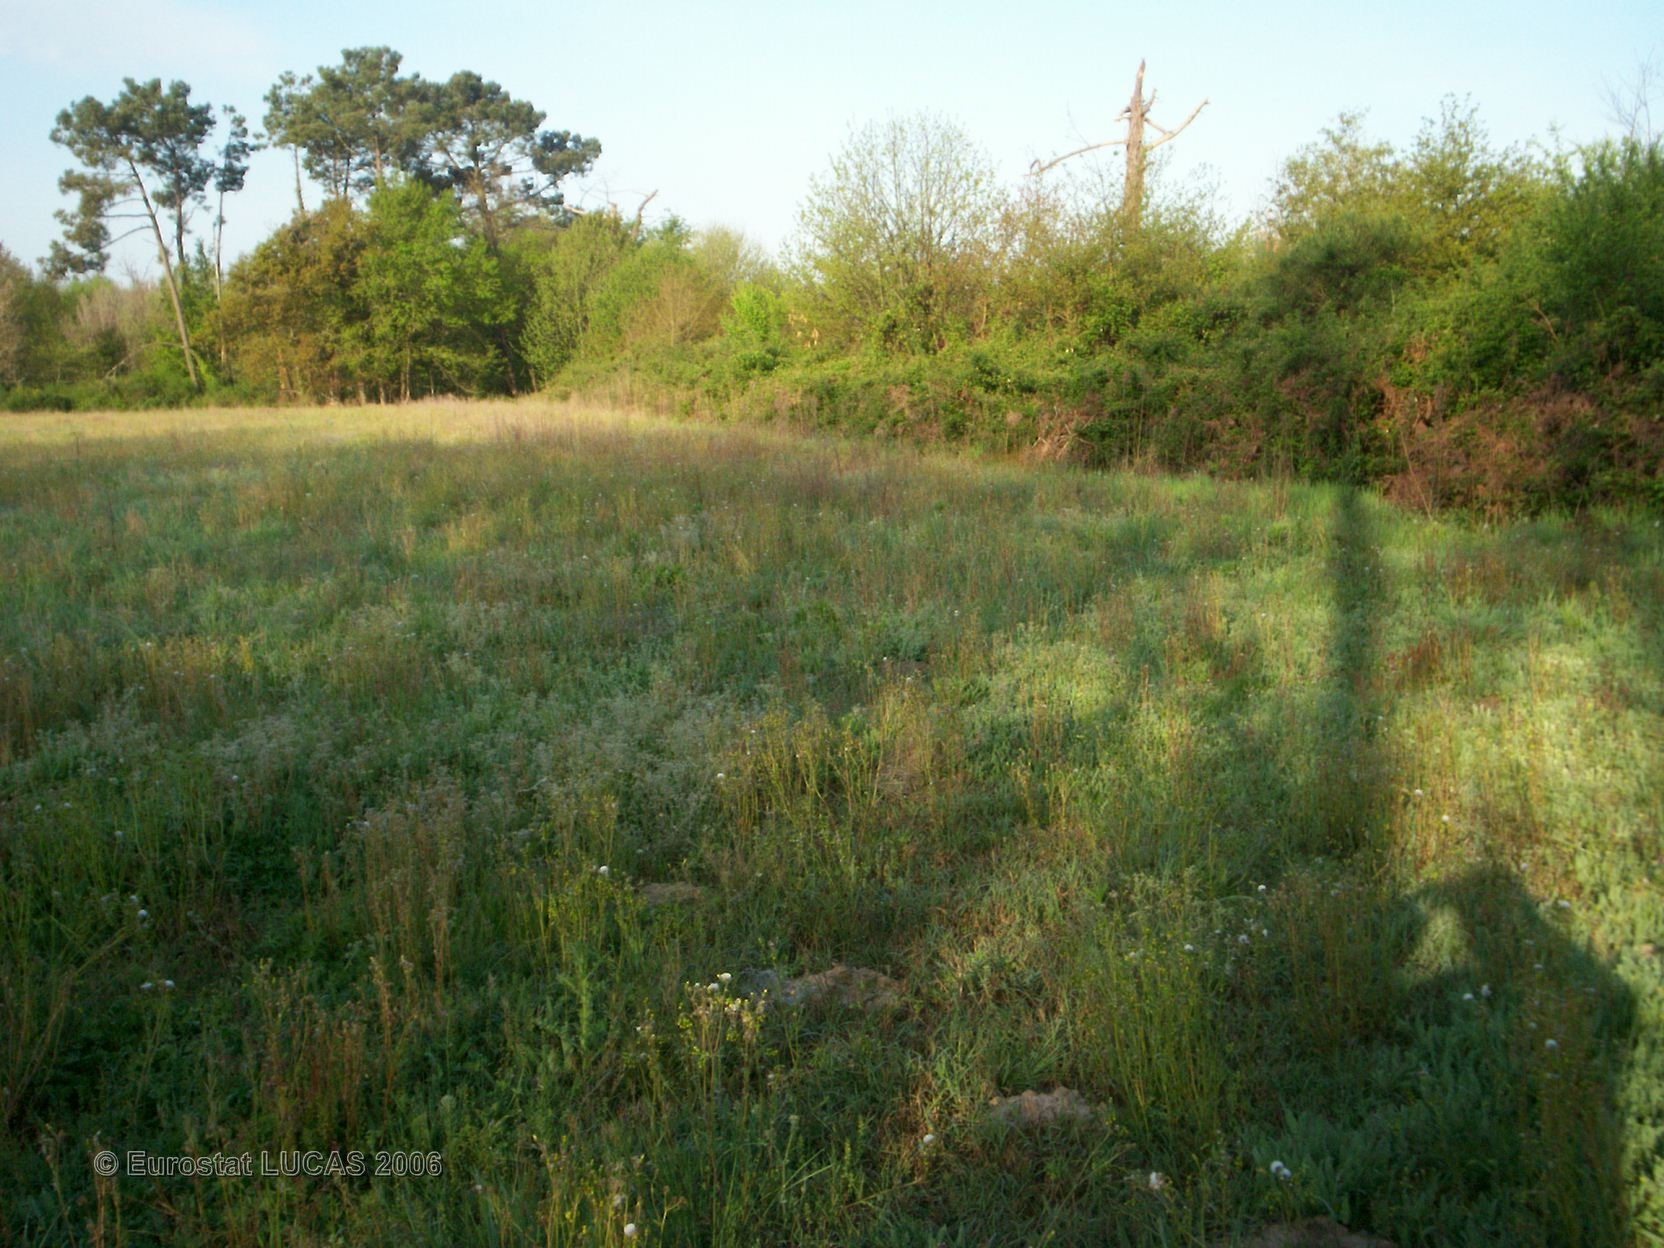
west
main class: Grassland
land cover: Grassland without tree/shrub cover
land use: Agriculture (excluding fallow land and kitchen gardens)
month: May
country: FR
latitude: 45.5183
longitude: -0.7391
